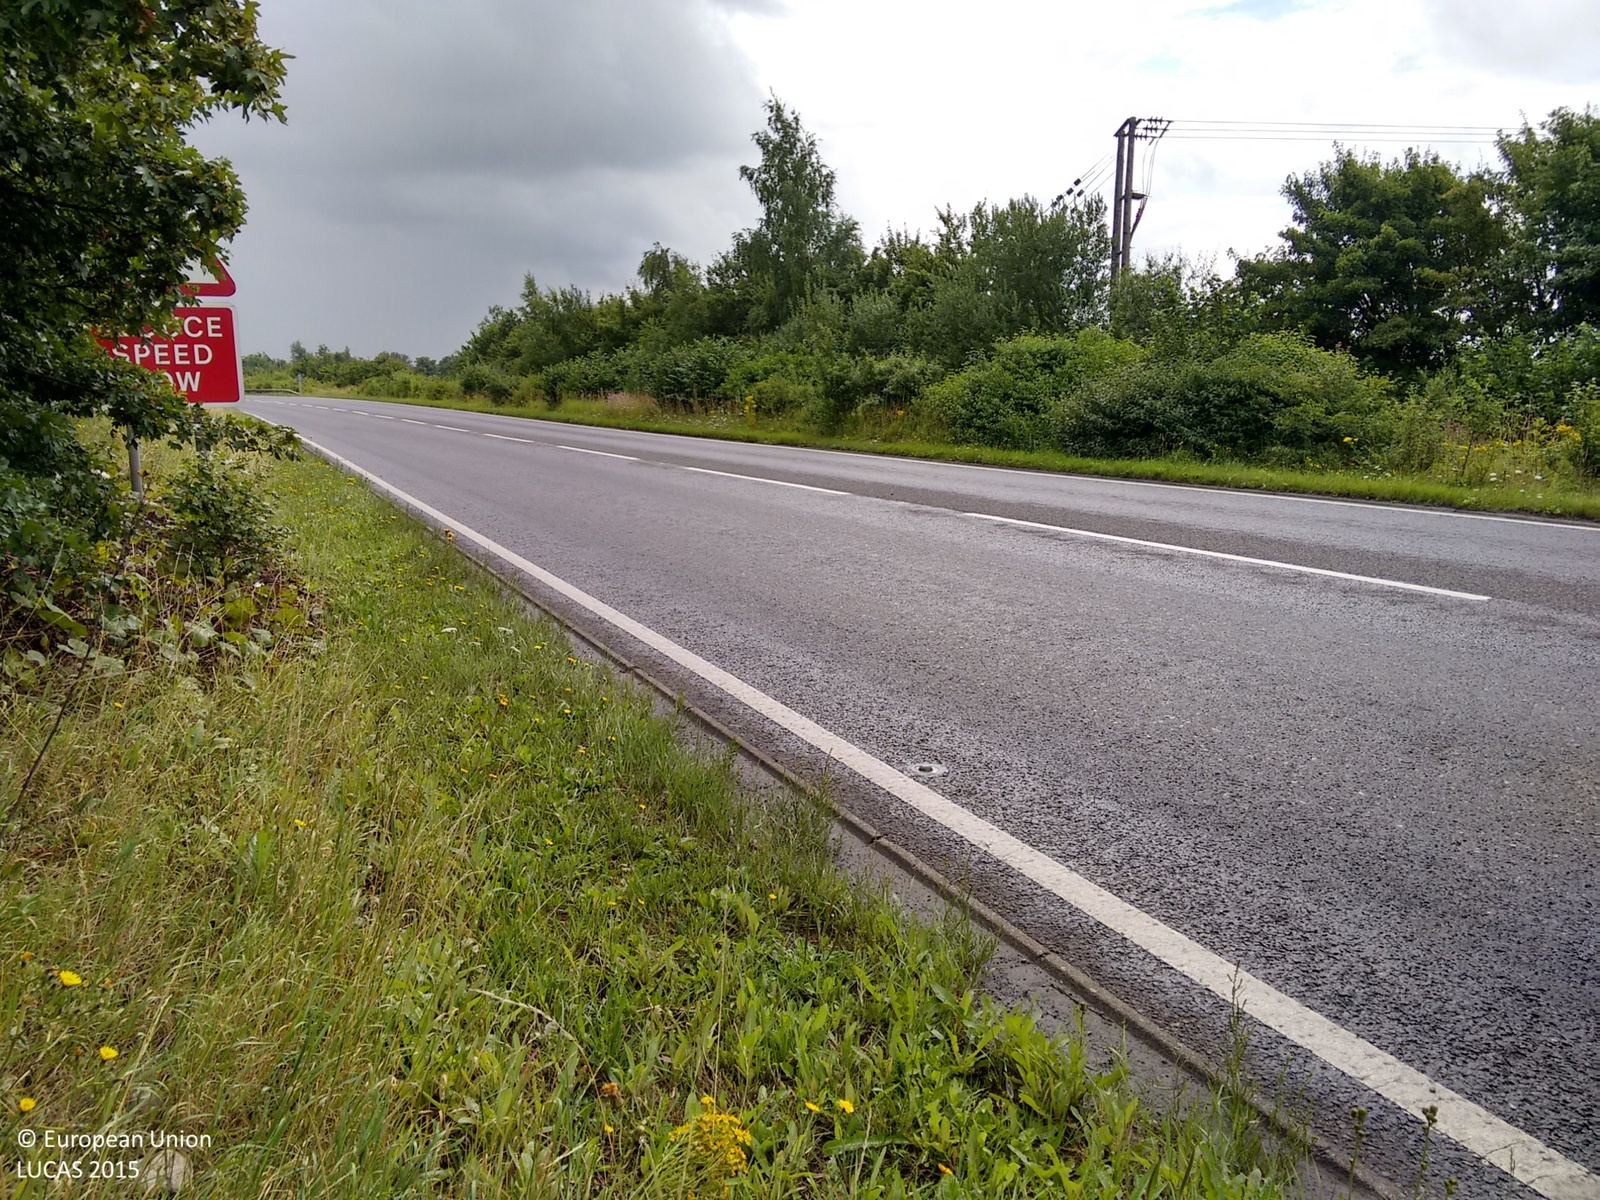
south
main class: Woodland
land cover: Broadleaved woodland
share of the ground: > 75 %
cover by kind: broadleaved forest trees 75 %, herbaceous plants 25 %
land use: Forestry
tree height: < 5 m
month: July
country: GB
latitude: 52.7788
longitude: 0.1103
